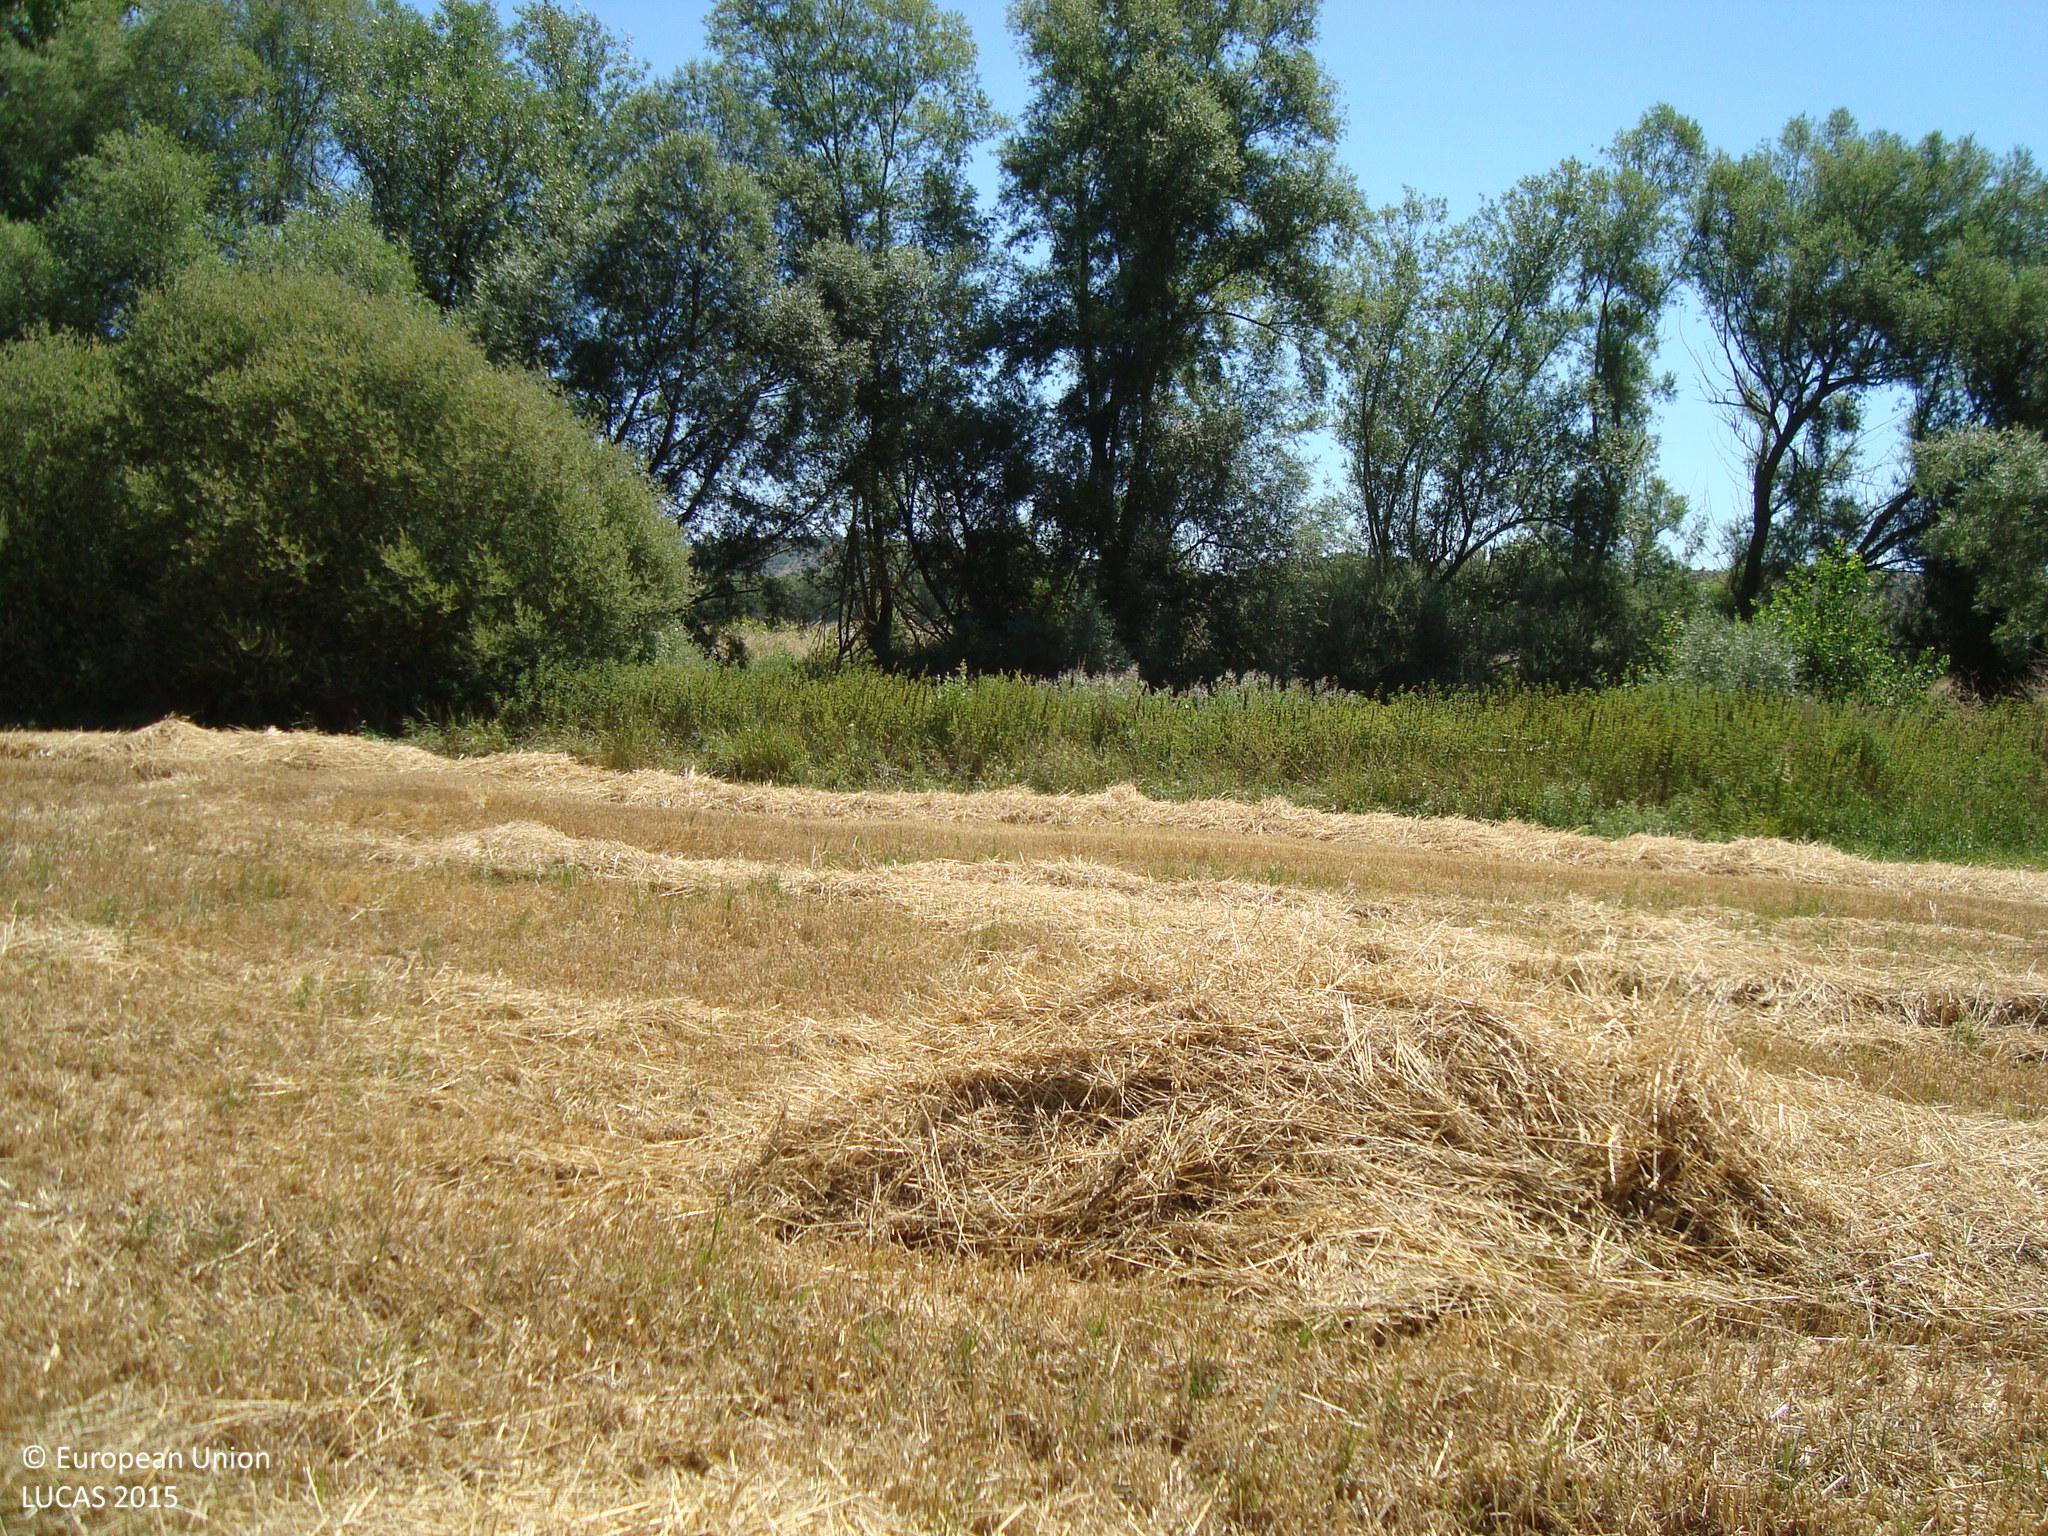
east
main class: Cropland
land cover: Common wheat
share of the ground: < 10 %
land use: Agriculture (excluding fallow land and kitchen gardens)
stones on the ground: < 10 %
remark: Harvested field
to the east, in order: Common wheat; Pine dominated coniferous woodland; Inland fresh running water; Arable land (only in case pi)
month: July
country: ES
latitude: 42.2518
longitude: -3.9415
